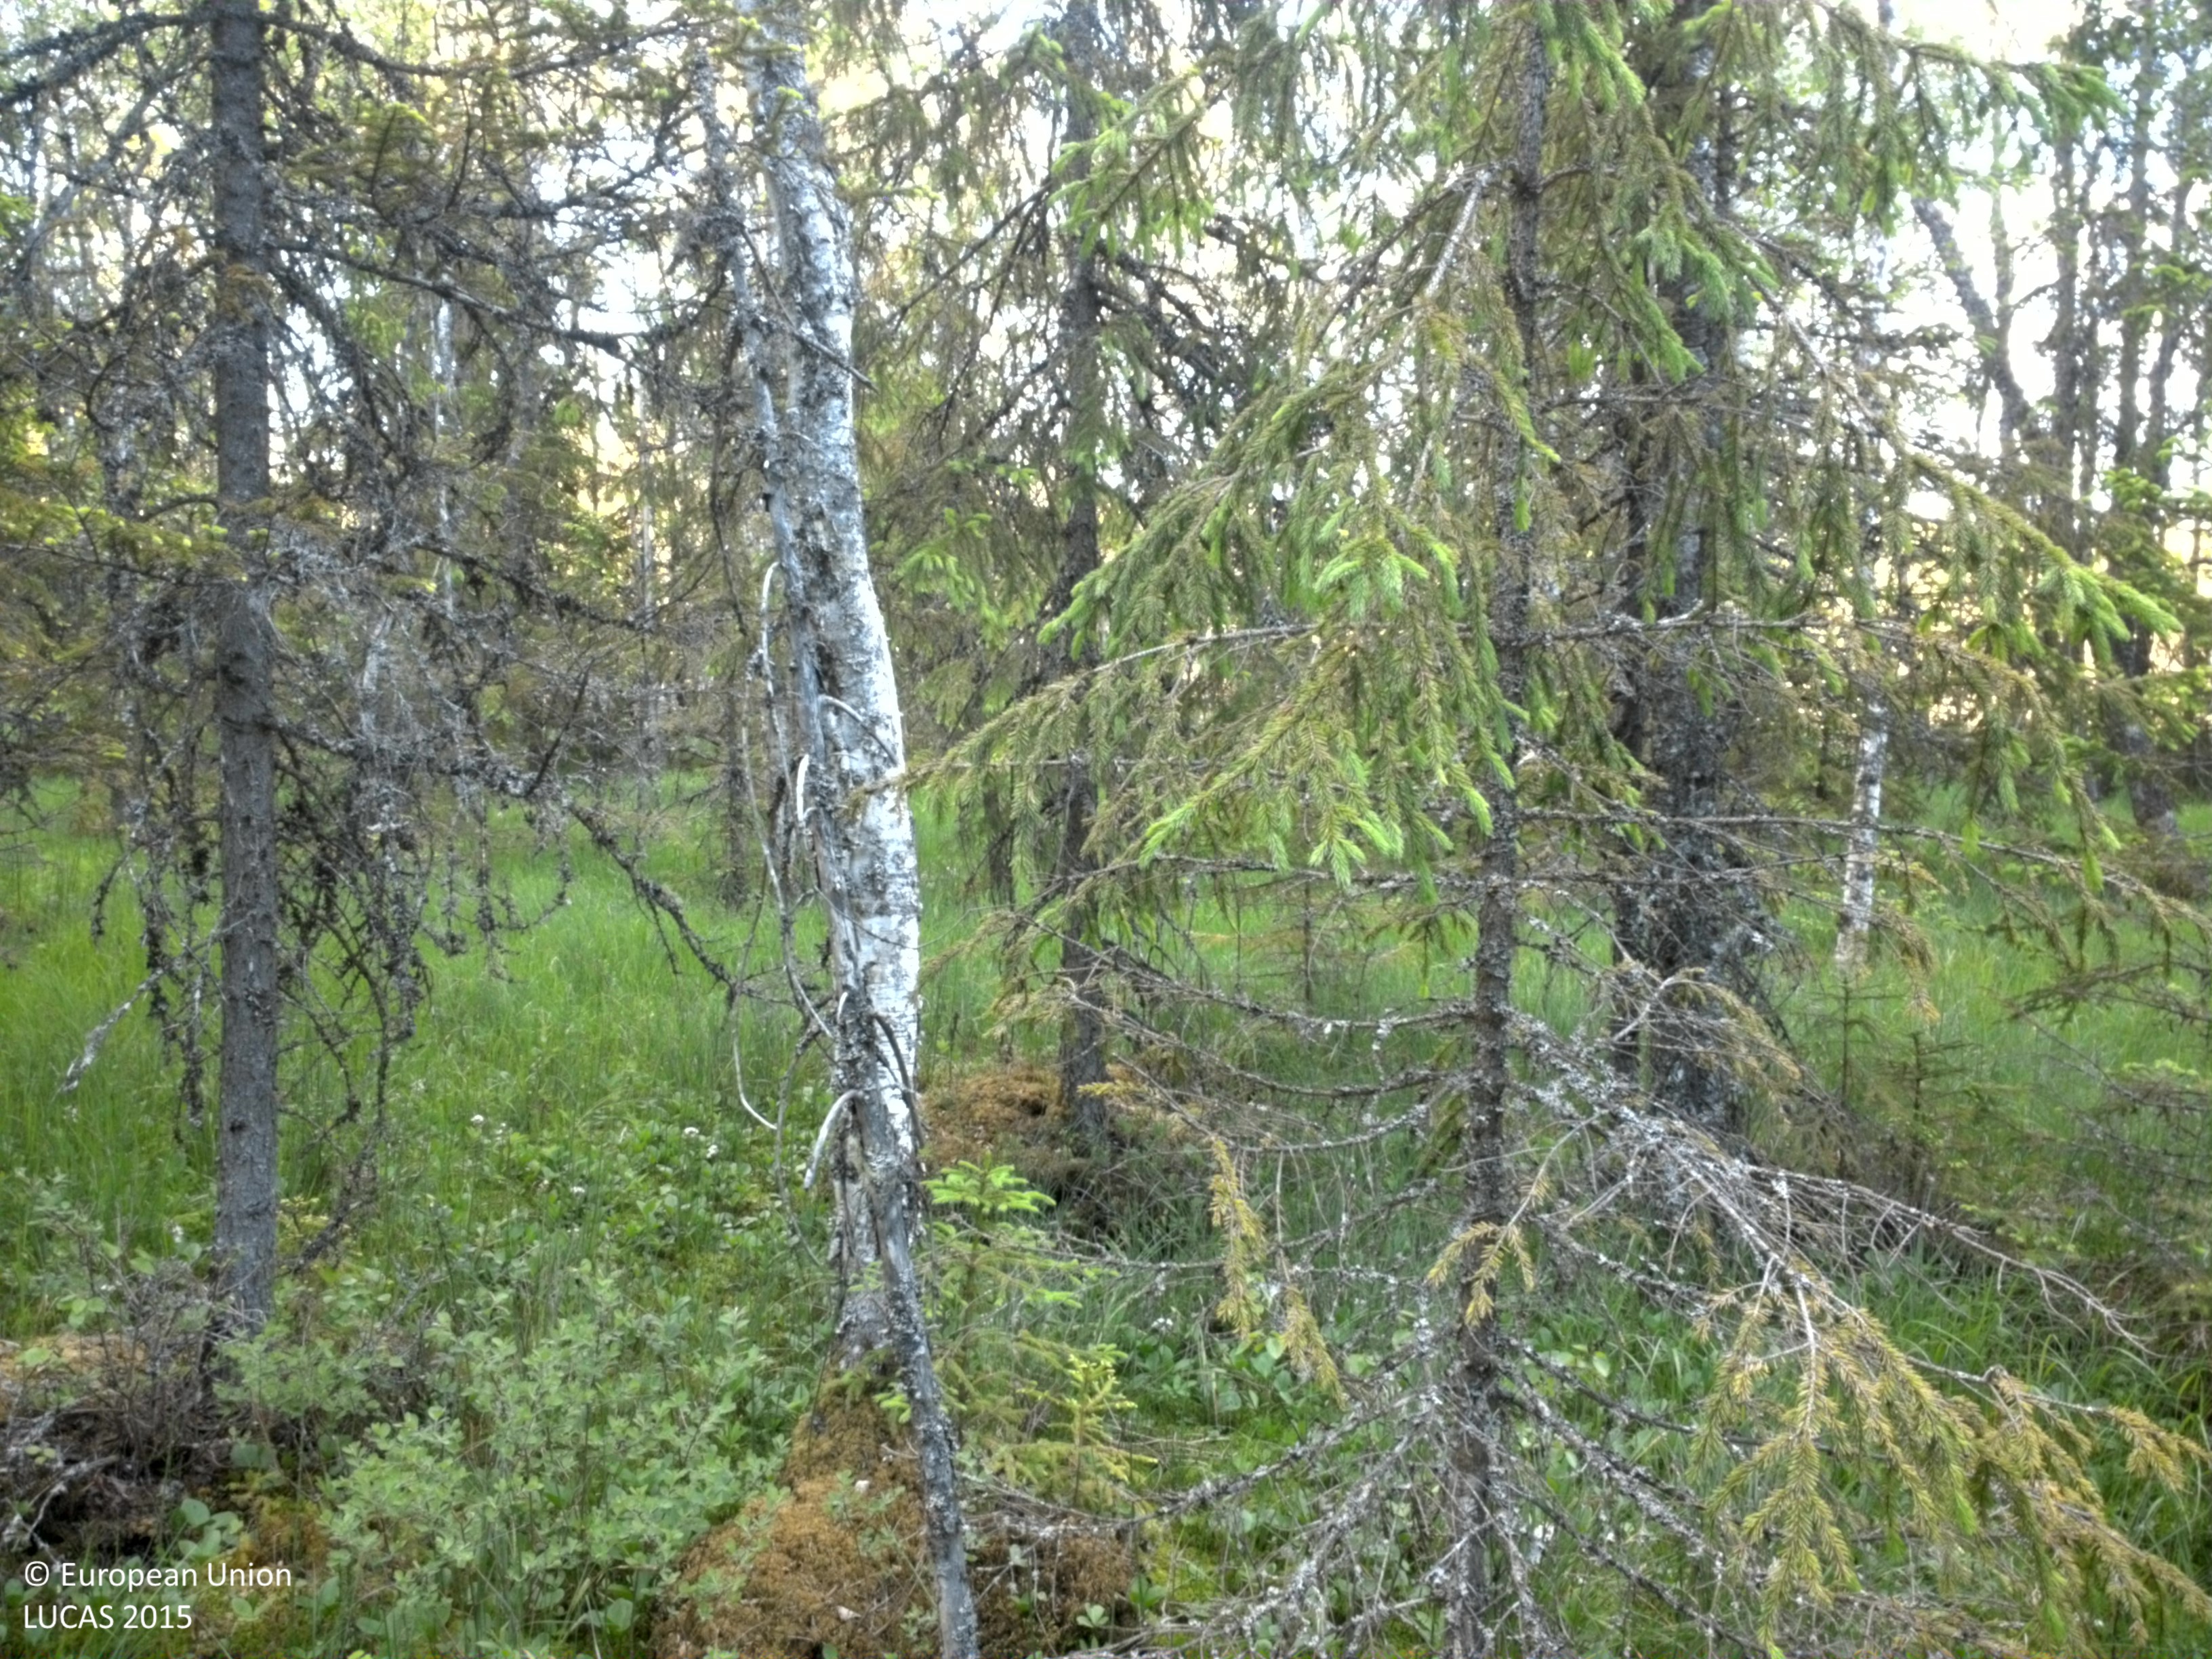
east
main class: Woodland
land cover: Spruce dominated mixed woodland
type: mire and swamp forests
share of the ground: 50 - 75 %
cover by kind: herbaceous plants 35 %, broadleaved forest trees 30 %, coniferous forest trees 20 %, lichens and mosses 15 %
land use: Semi-natural and natural areas not in use
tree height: > 5 m
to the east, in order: Spruce dominated mixed woodland; Rivers and streams; Spruce dominated mixed woodland; Spruce dominated coniferous woodland
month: June
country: SE
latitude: 59.6158
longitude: 14.1209
